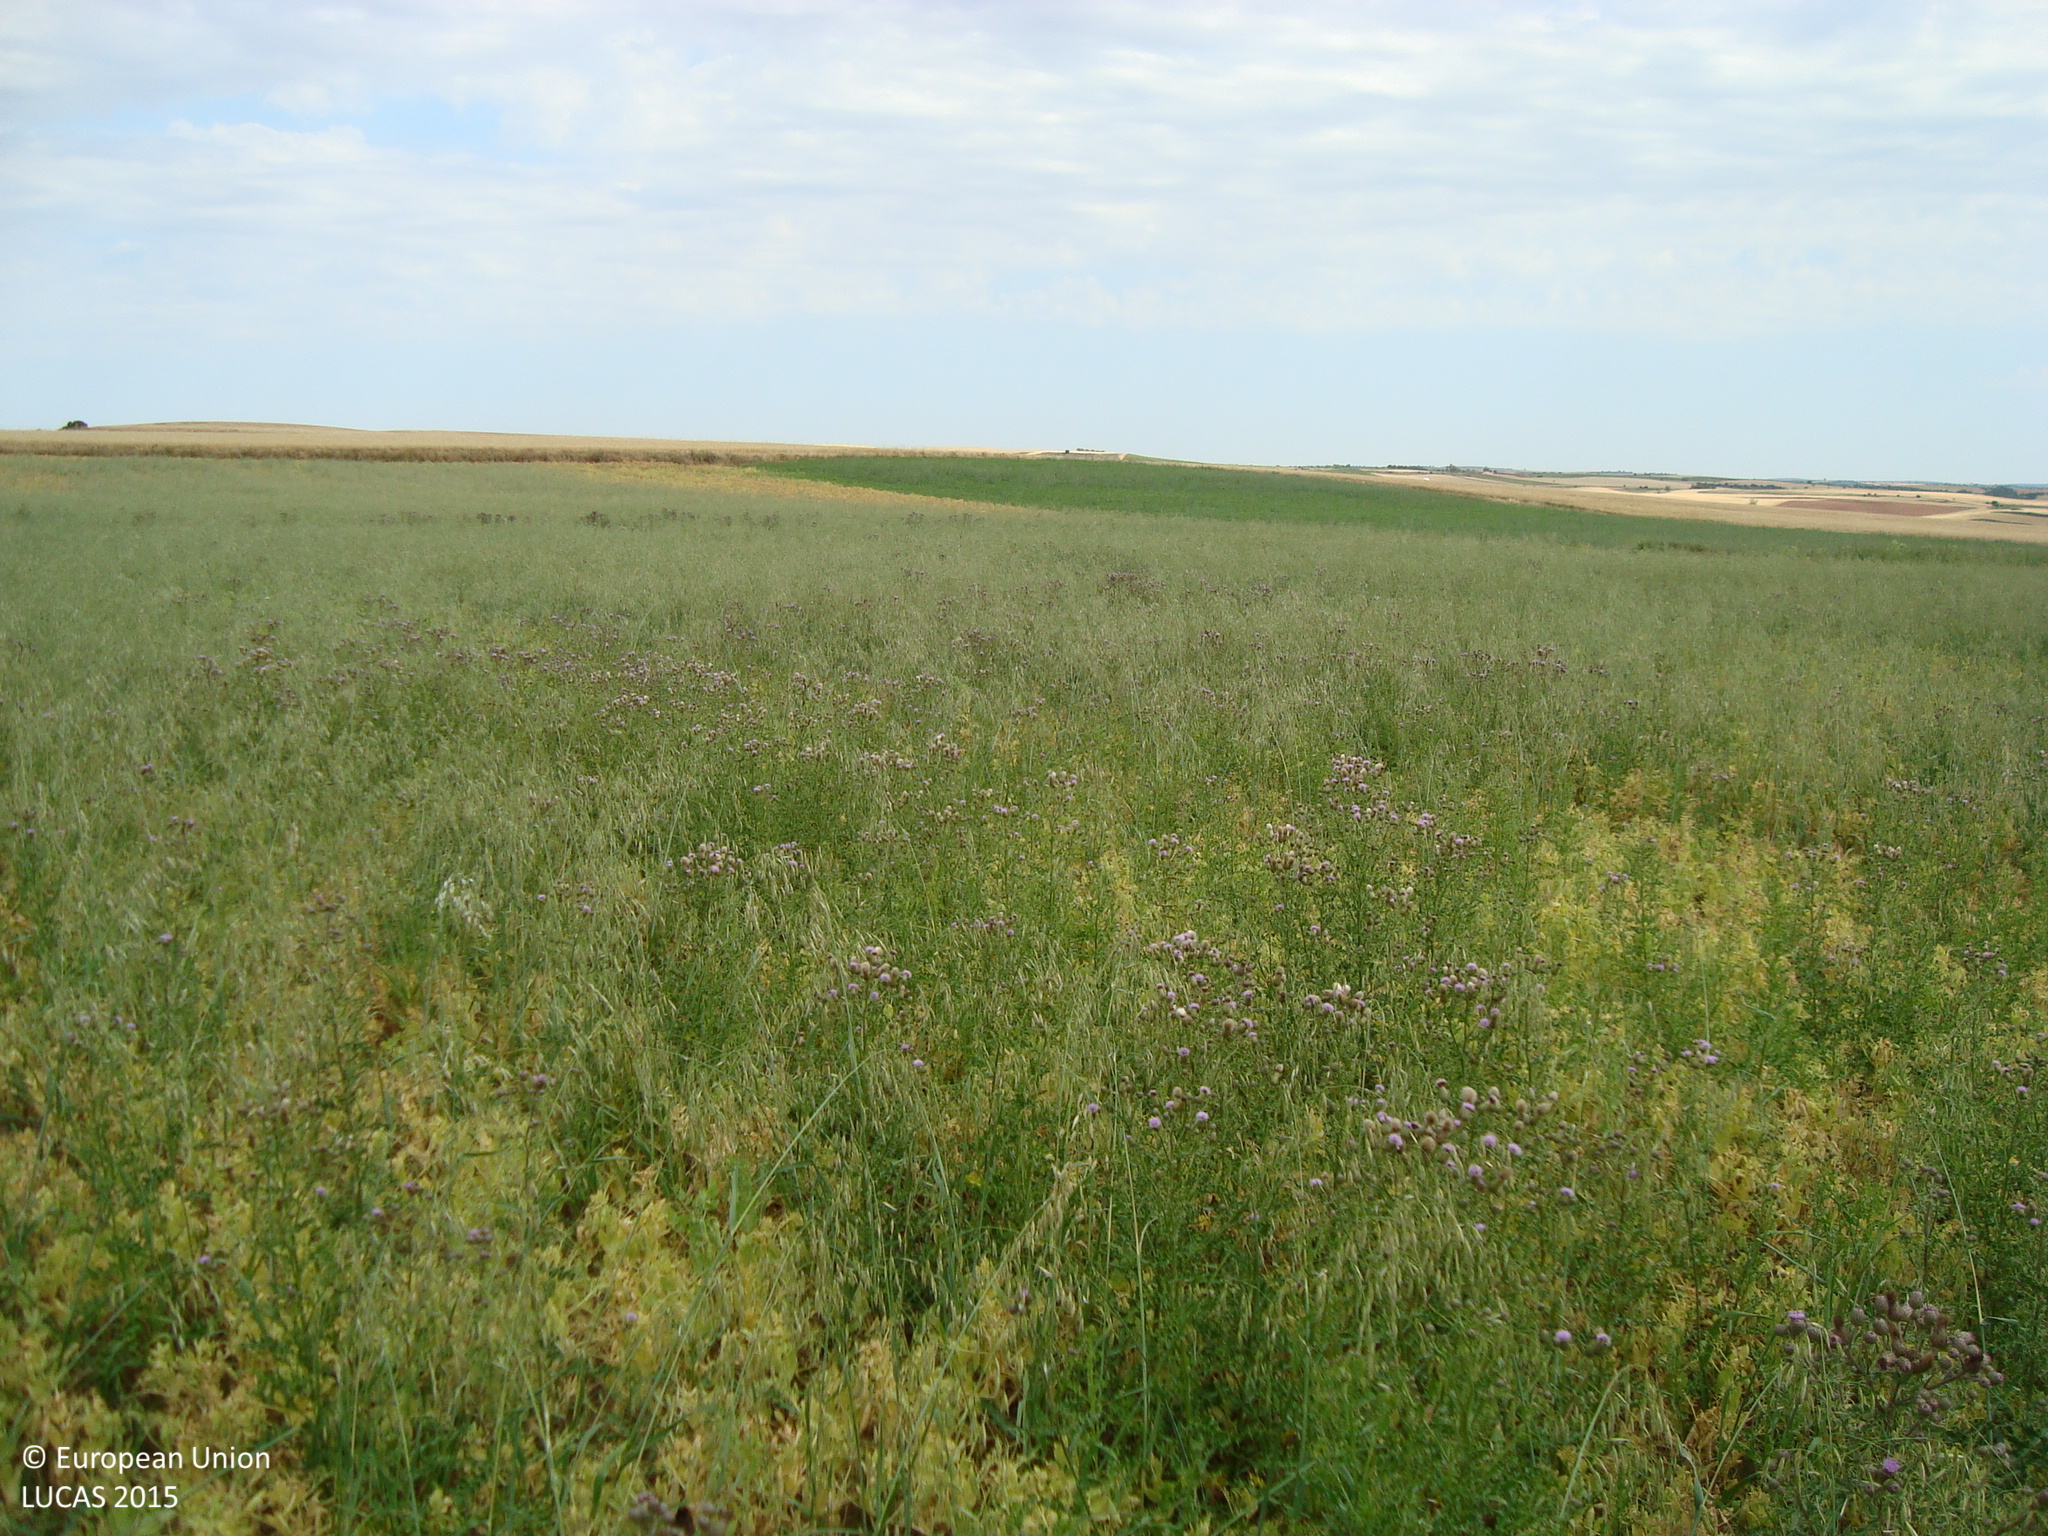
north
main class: Cropland
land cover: Dry pulses
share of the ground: > 75 %
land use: Agriculture (excluding fallow land and kitchen gardens)
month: June
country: ES
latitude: 41.9768
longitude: -3.6814
